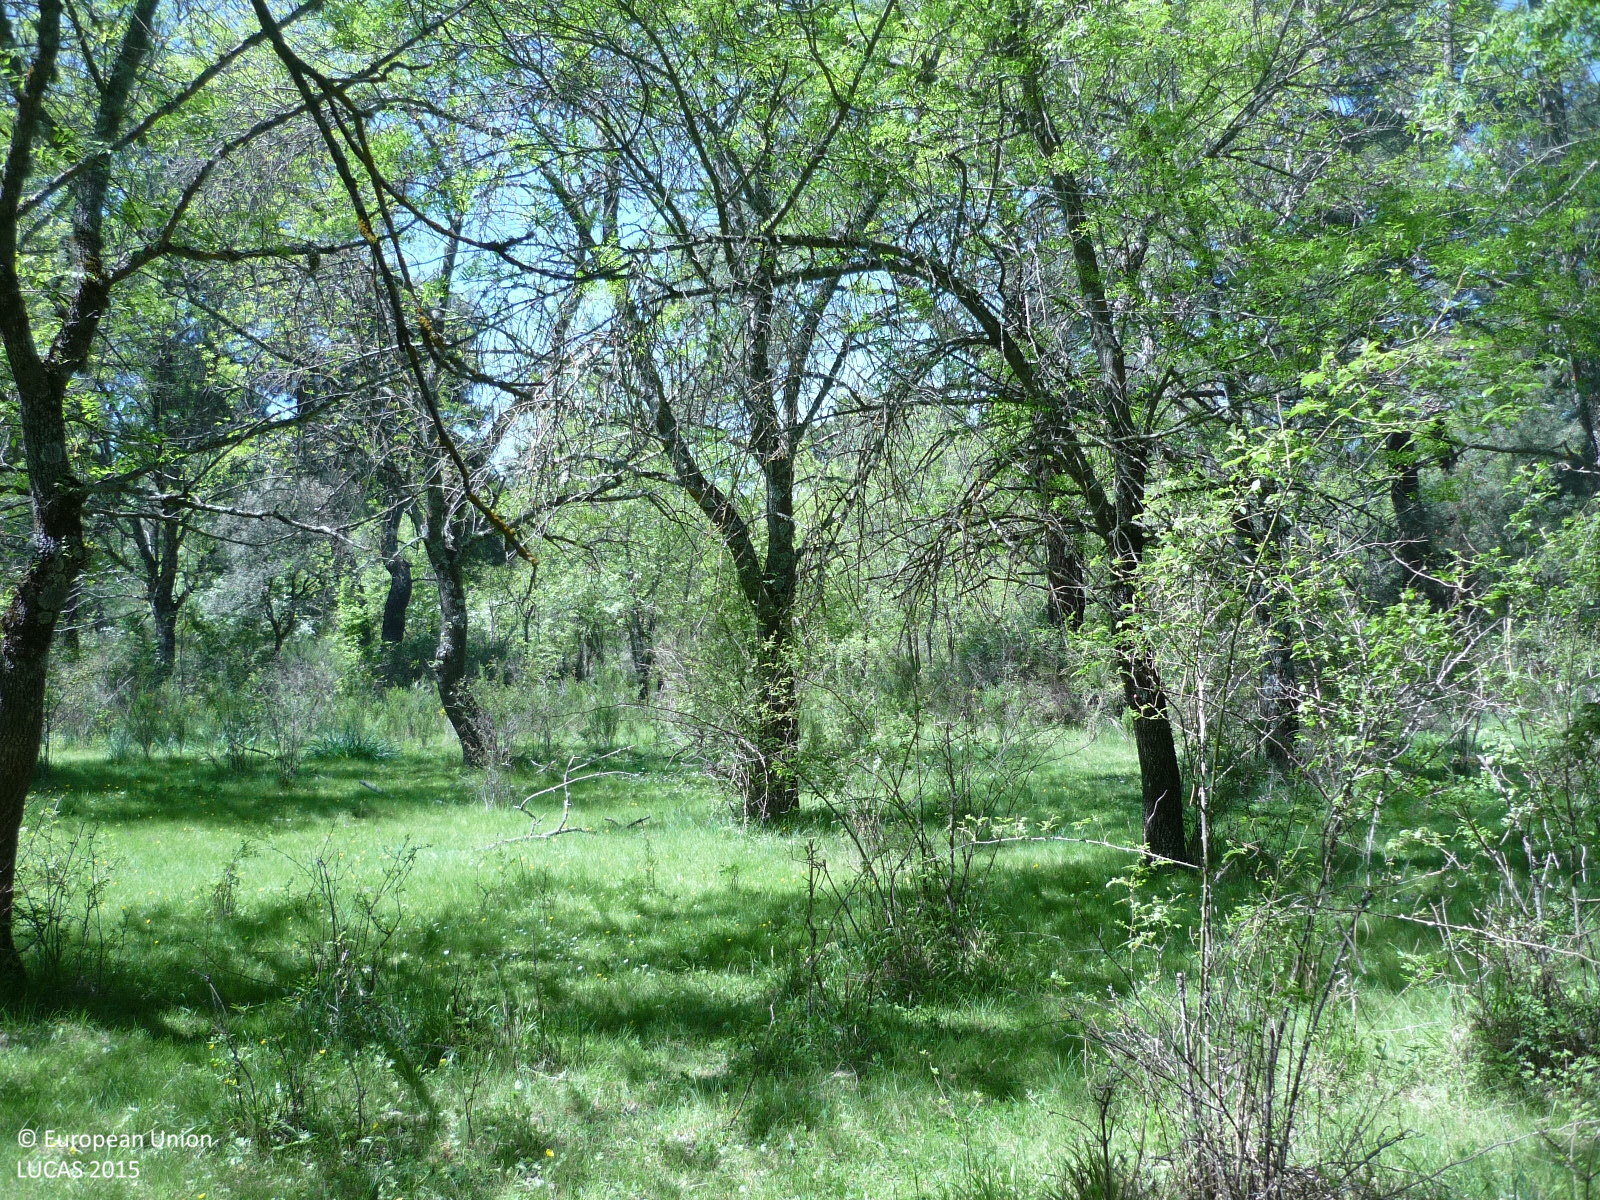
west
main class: Woodland
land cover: Broadleaved woodland
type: thermophilous deciduous forest
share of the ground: > 75 %
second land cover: Grassland without tree/shrub cover
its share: > 75 %
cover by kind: broadleaved forest trees 90 %, herbaceous plants 10 %
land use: Forestry
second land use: Agriculture (excluding fallow land and kitchen gardens)
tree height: < 5 m
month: May
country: ES
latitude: 40.9812
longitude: -3.6042
